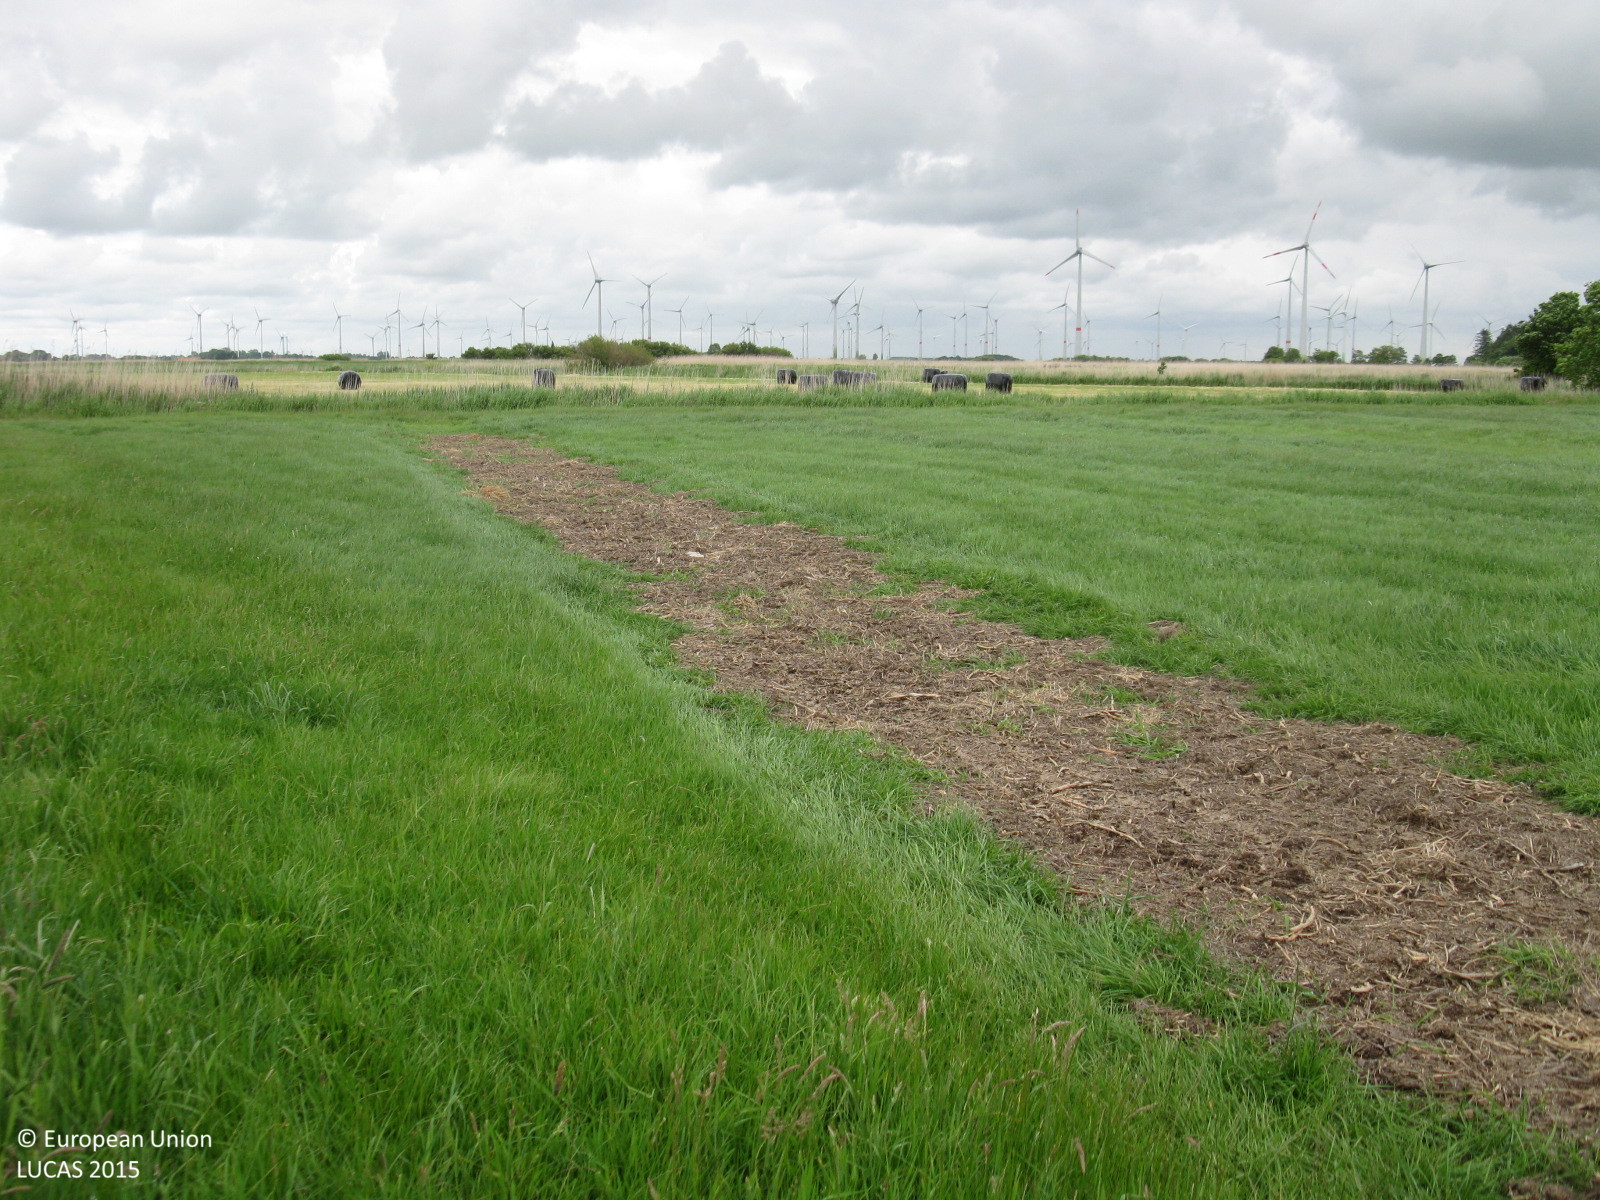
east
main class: Cropland
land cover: Temporary grasslands
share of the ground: > 75 %
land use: Agriculture (excluding fallow land and kitchen gardens)
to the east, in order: Temporary grasslands; Ditches and canals; Shruby margins; Grassland without tree/shrub cover; Shruby margins; Inland fresh running water; Grassland without tree/shrub cover; Inland fresh running water; Grassland without tree/shrub cover
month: June
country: DE
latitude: 53.6255
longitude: 7.3849
